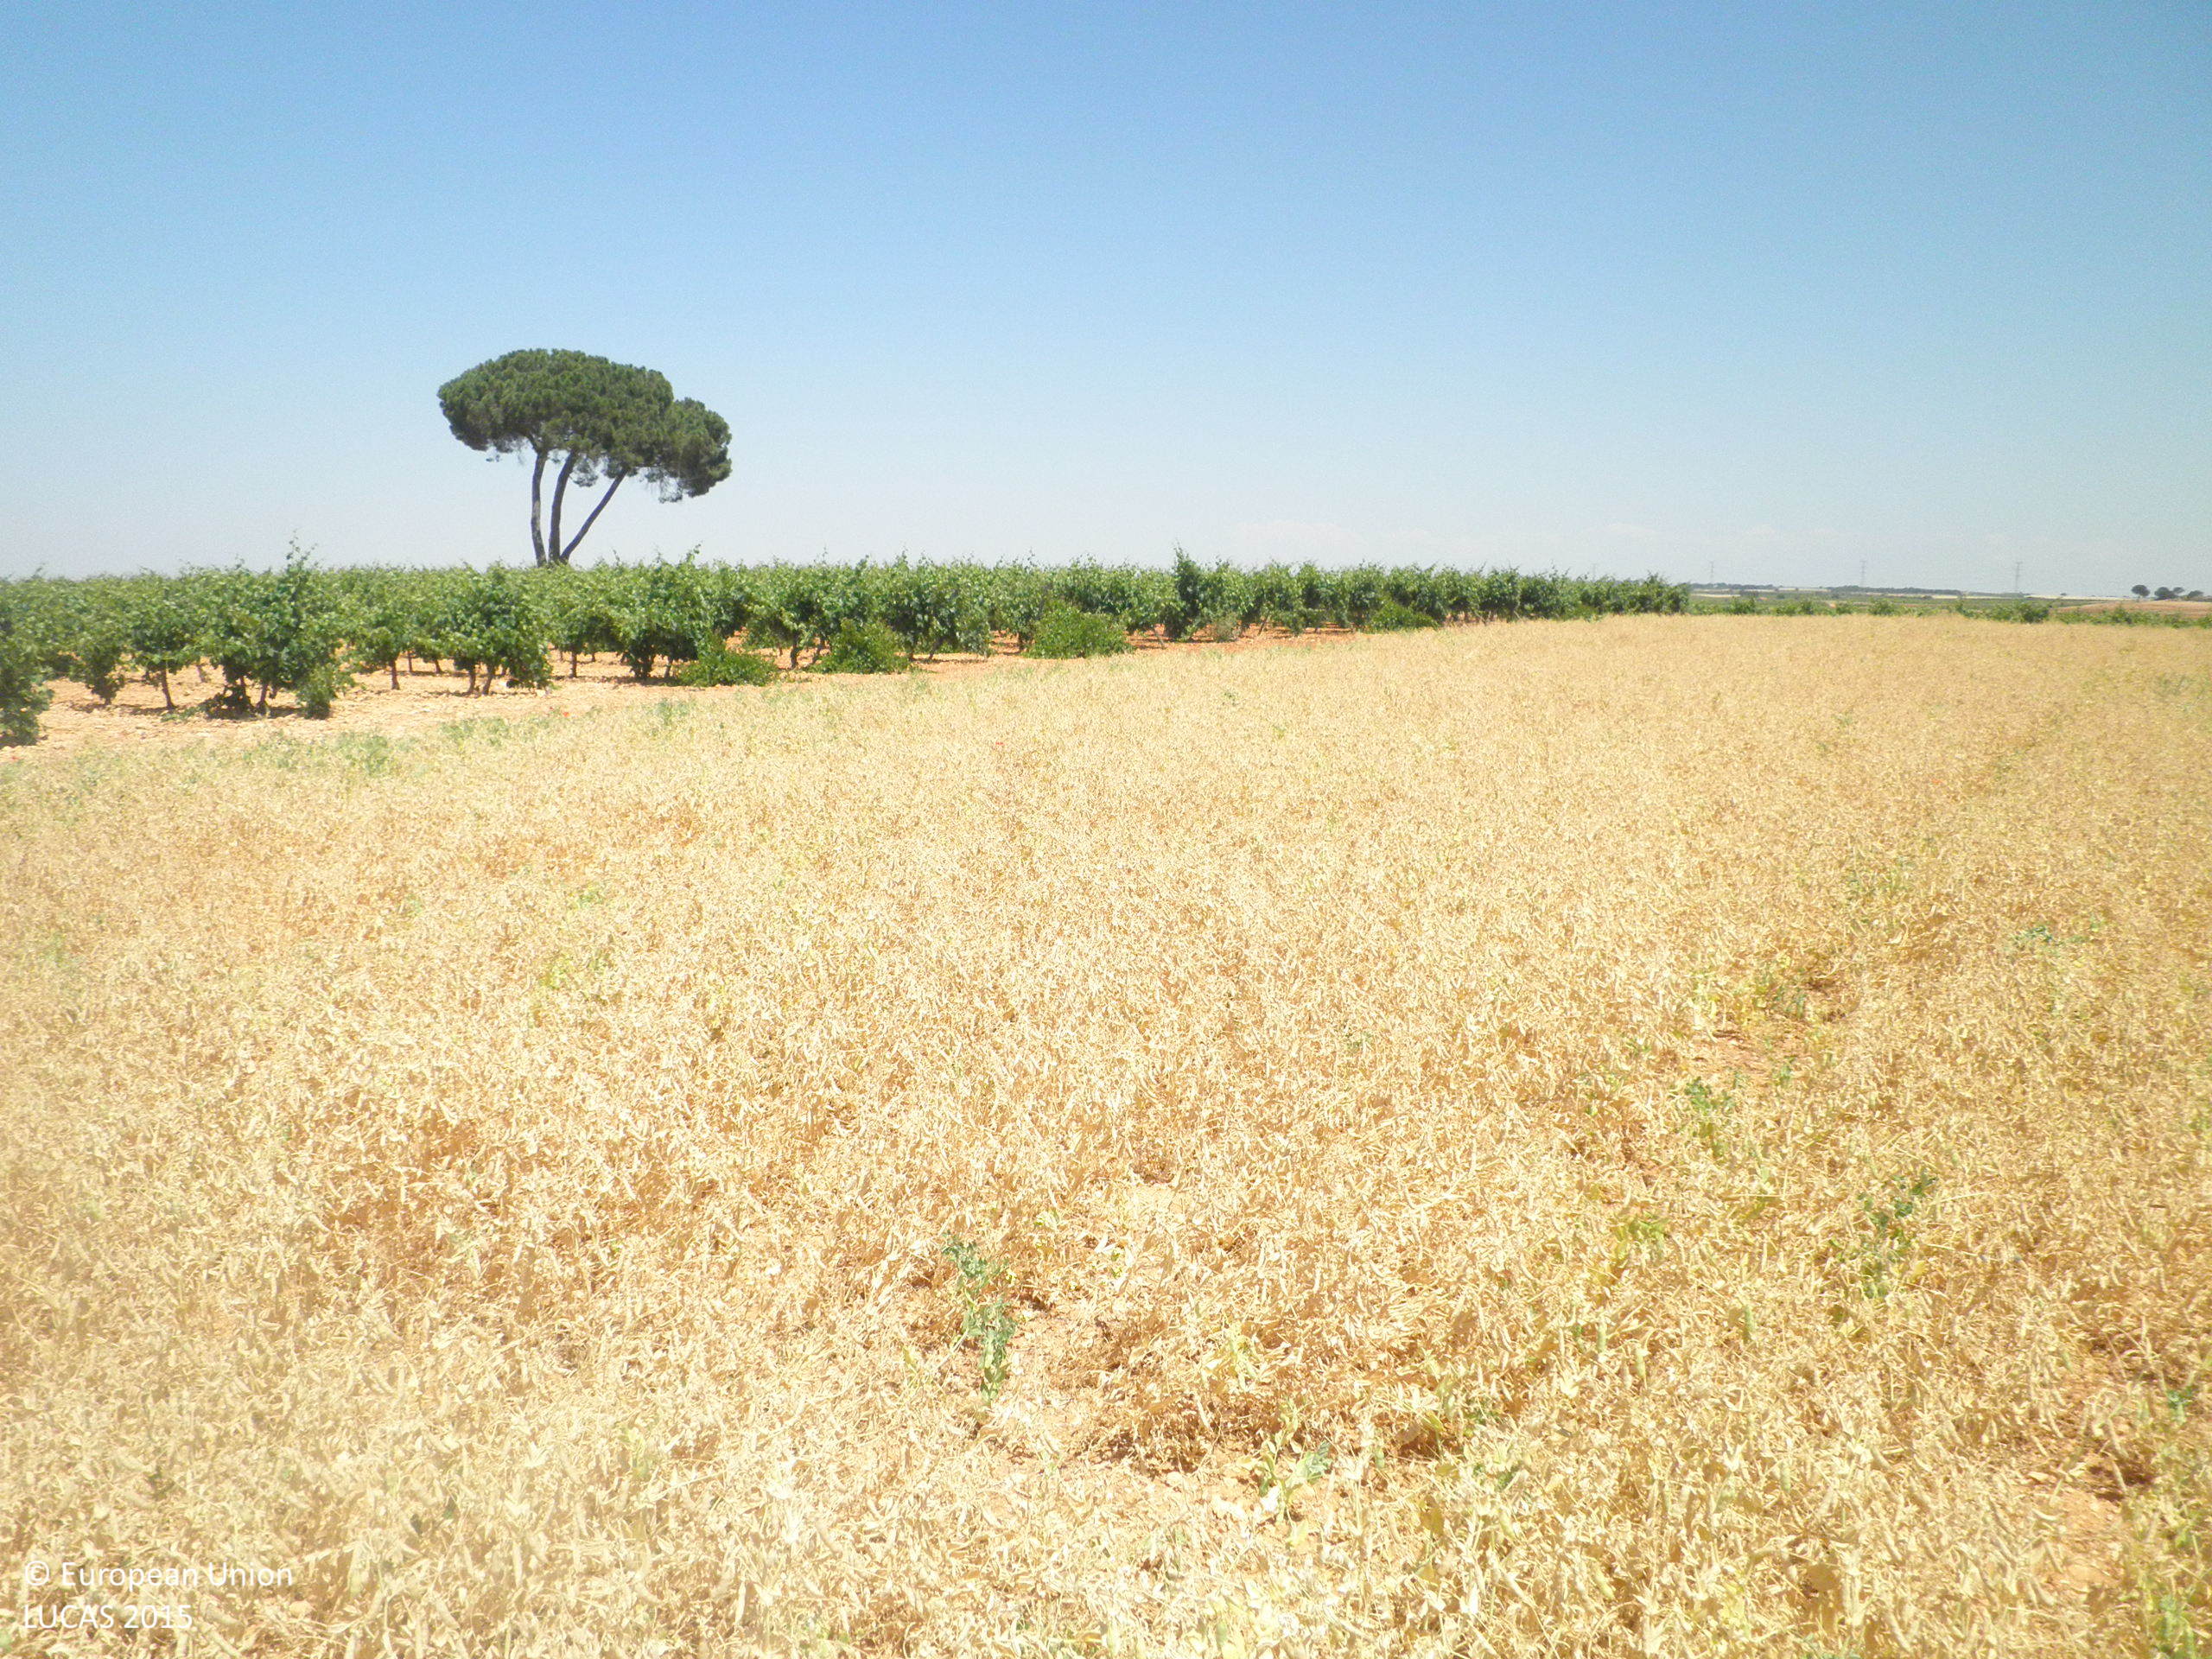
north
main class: Cropland
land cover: Dry pulses
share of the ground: > 75 %
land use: Agriculture (excluding fallow land and kitchen gardens)
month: June
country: ES
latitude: 39.2944
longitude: -1.8190
